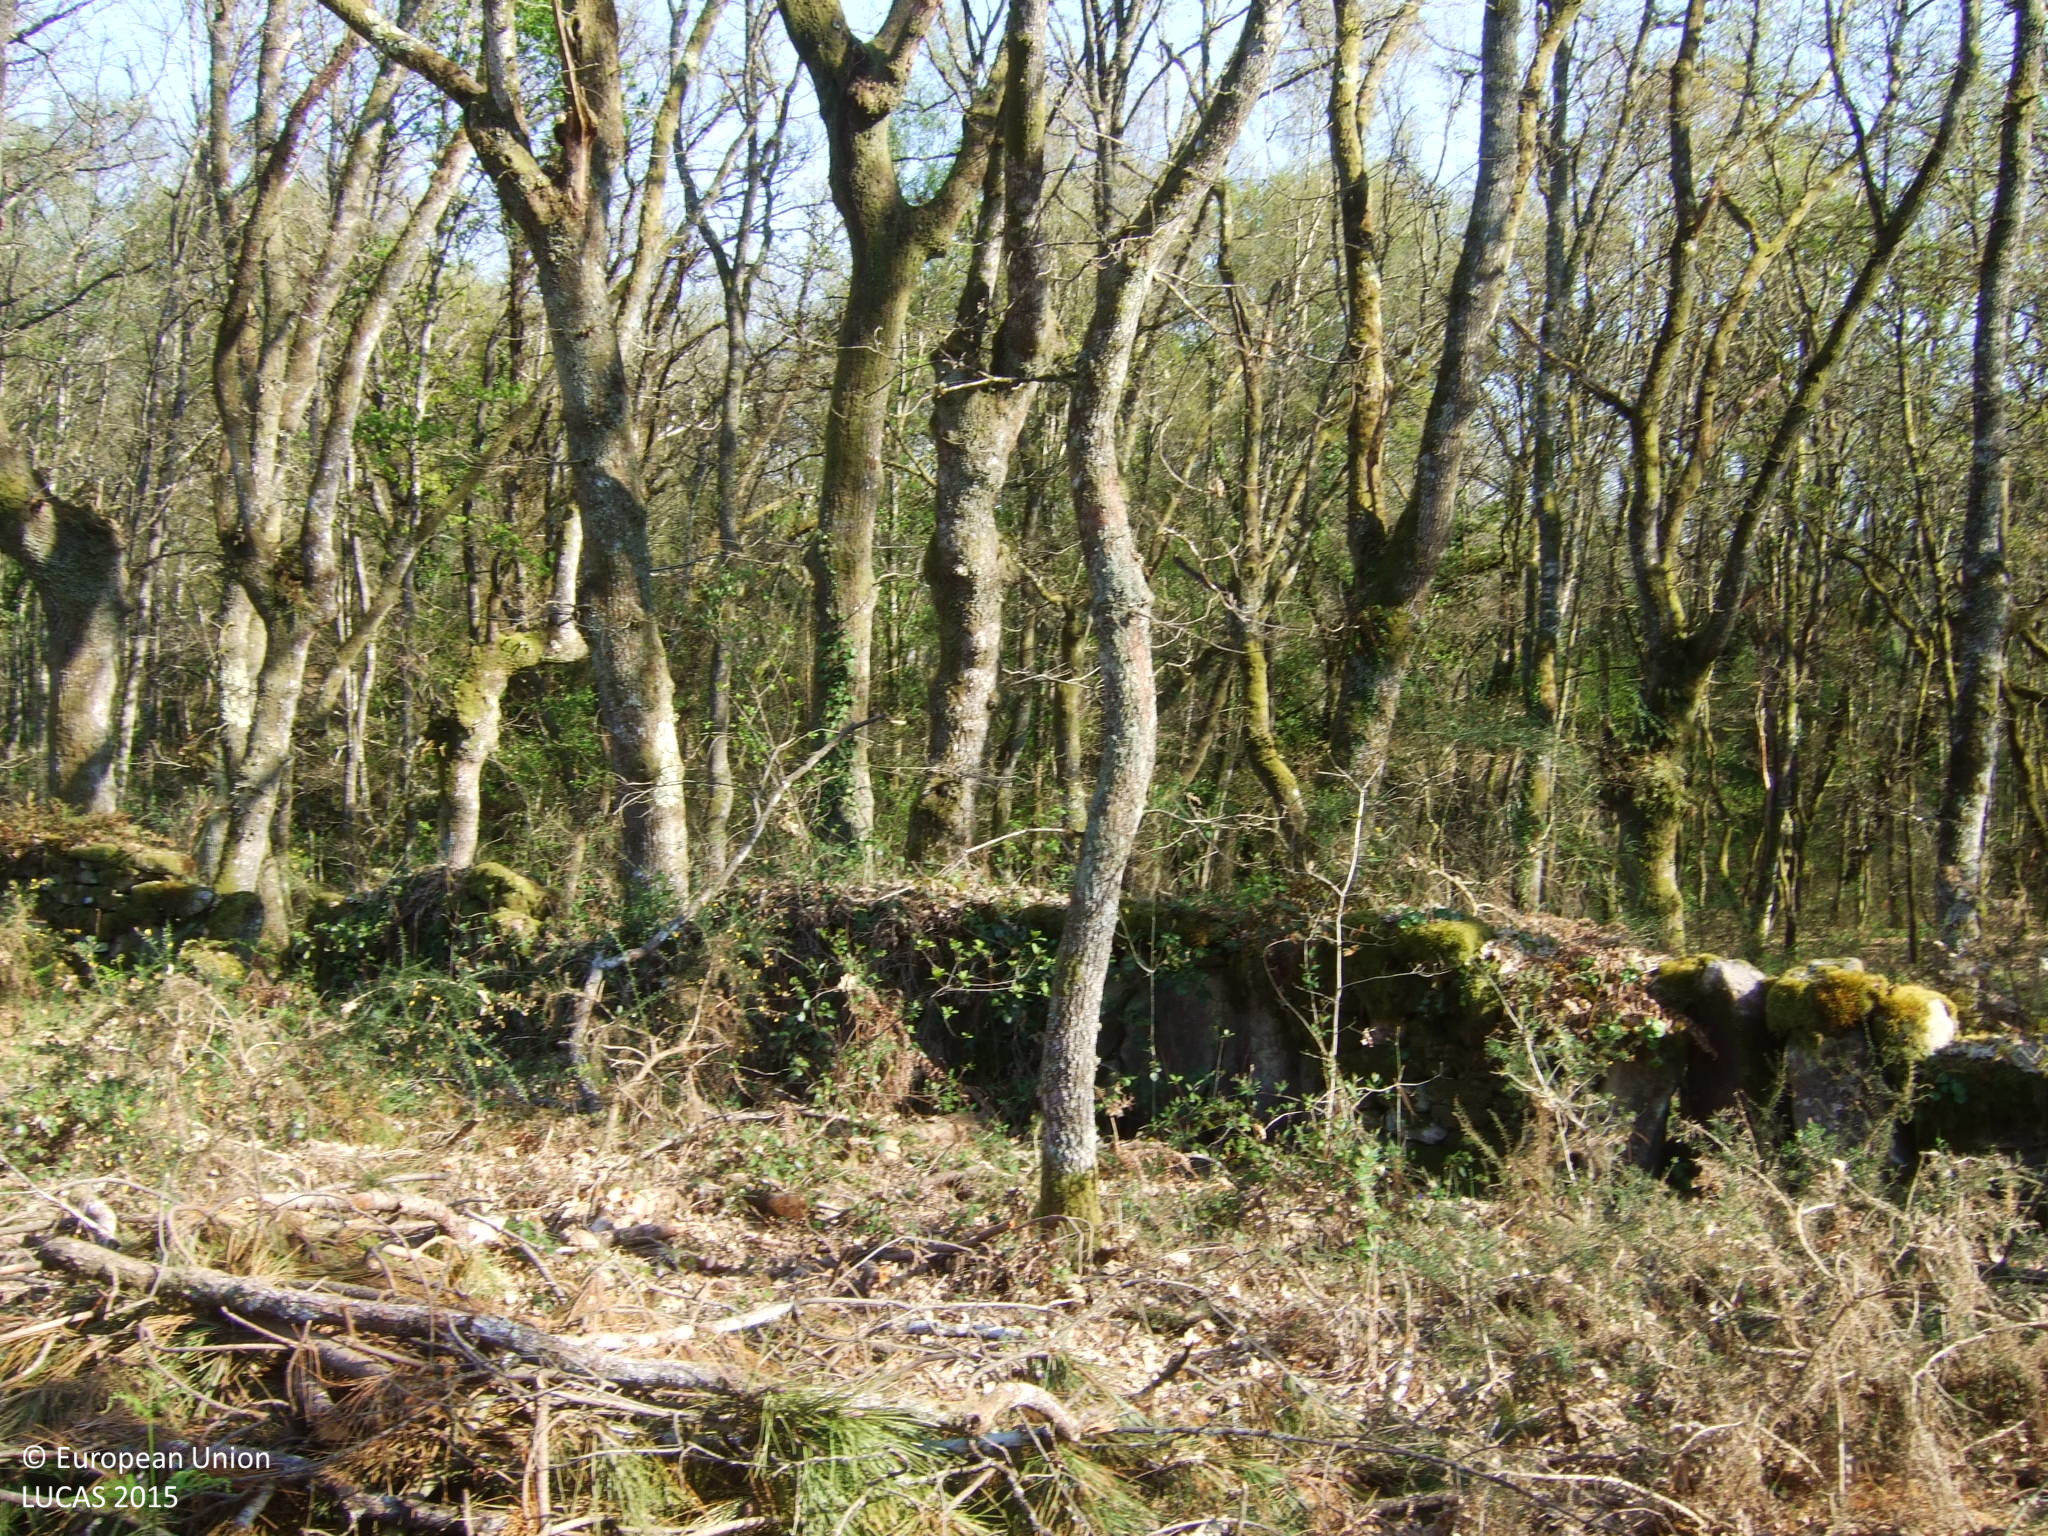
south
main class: Woodland
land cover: Broadleaved woodland
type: acidophilous oak and oak-birch forest
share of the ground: 10 - 25 %
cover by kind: unconsolidated bare surface 85 %, broadleaved forest trees 15 %
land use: Forestry
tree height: > 5 m
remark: Clear cut
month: April
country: ES
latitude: 43.0488
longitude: -7.6226
